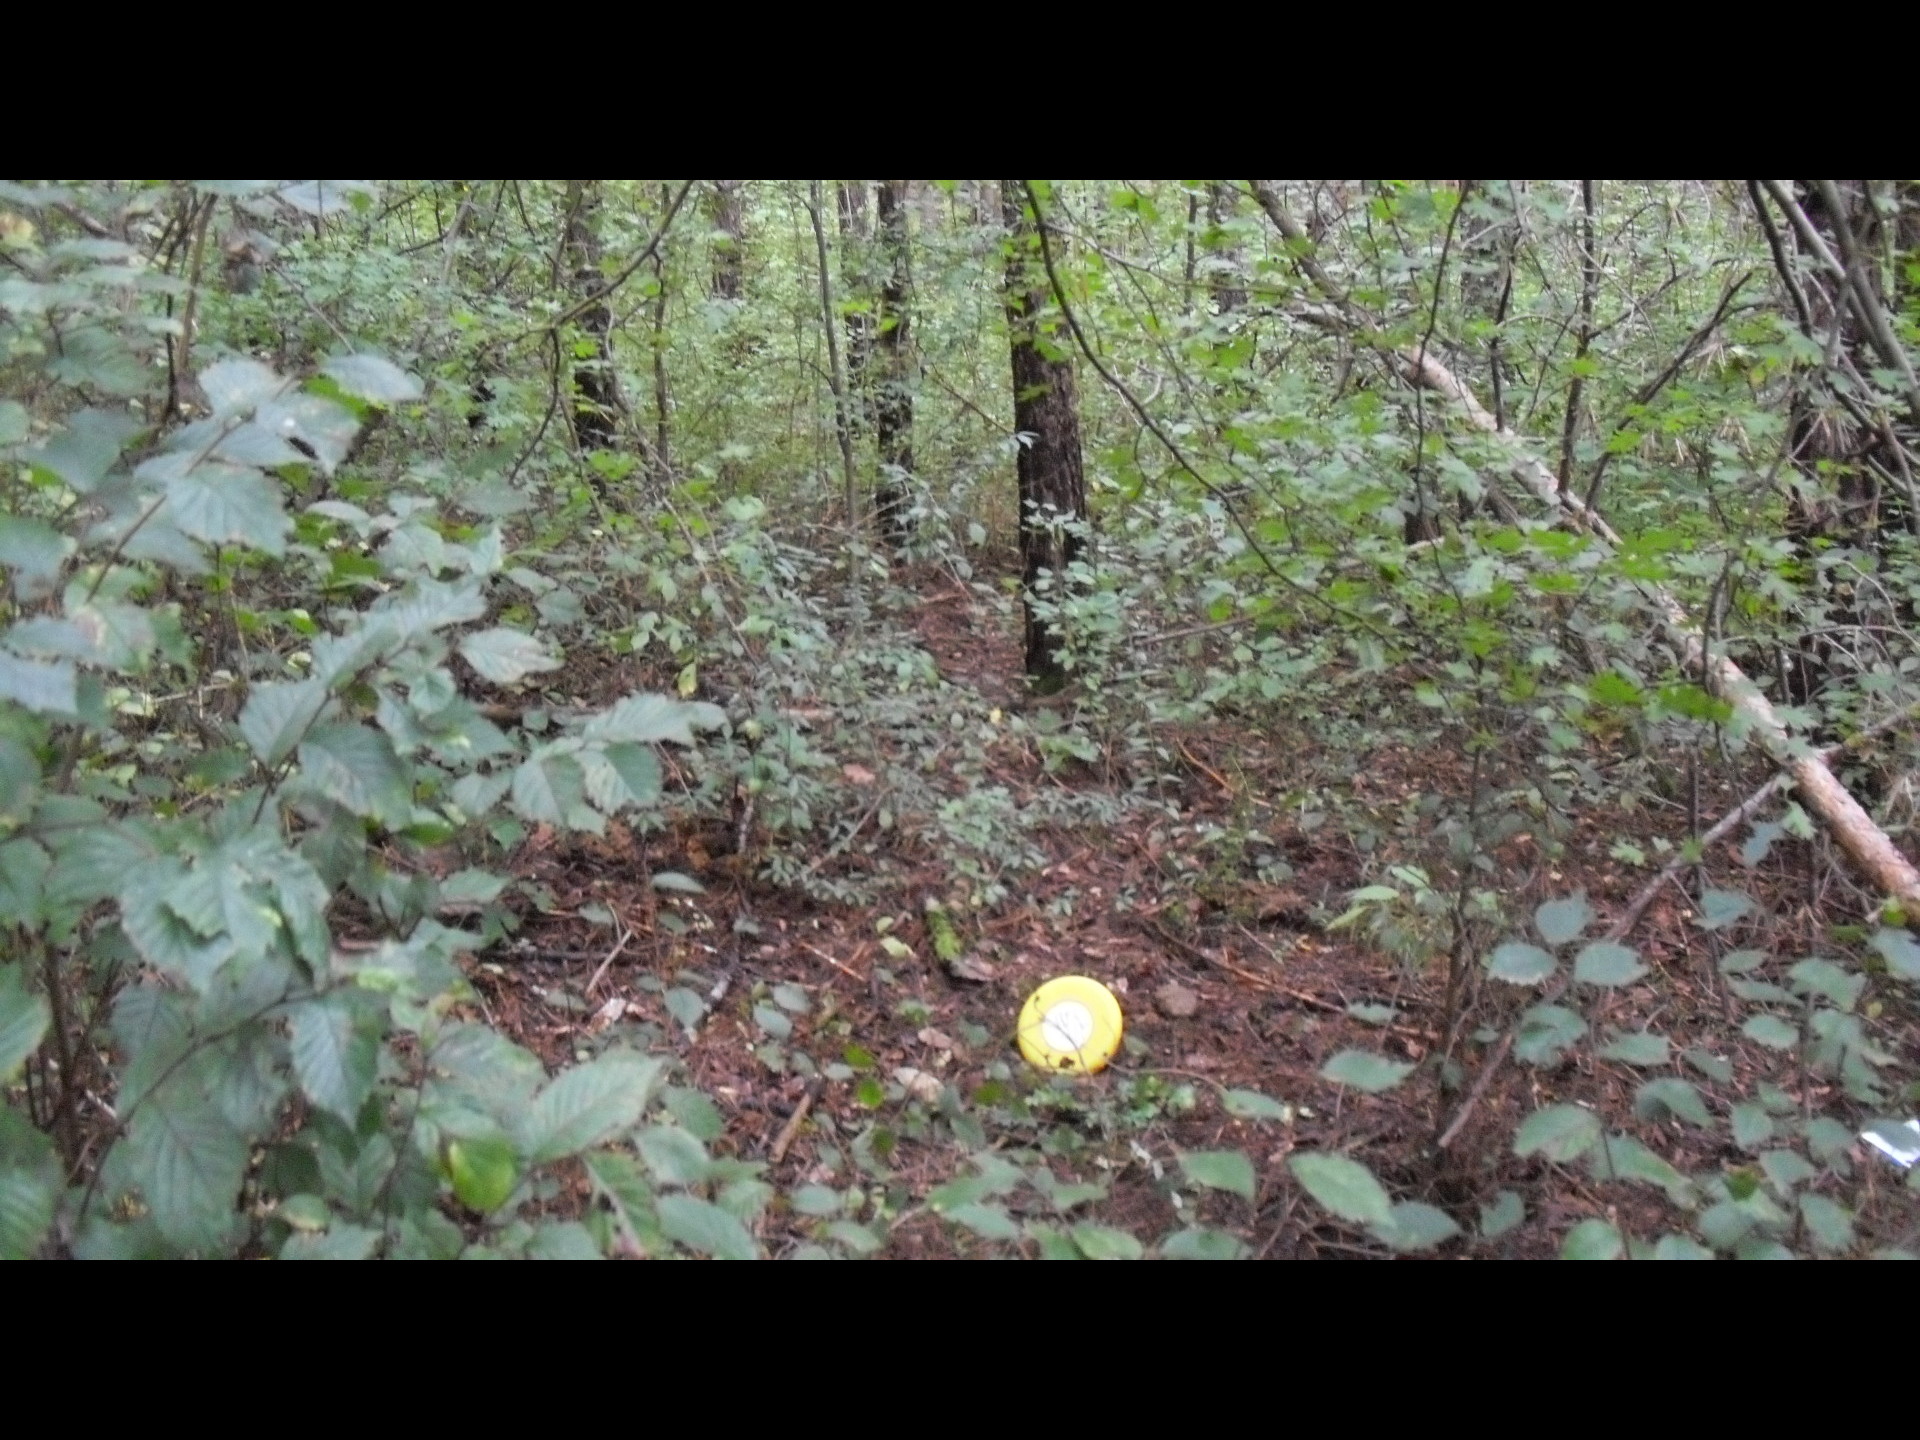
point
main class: Woodland
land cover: Pine dominated mixed woodland
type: hemiboreal forest and nemoral coniferous forest and mixed broadleaved-coniferous forest
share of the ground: > 75 %
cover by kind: coniferous forest trees 75 %, broadleaved forest trees 25 %
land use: Forestry
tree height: > 5 m
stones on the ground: 10 - 25 %
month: September
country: BG
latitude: 43.3337
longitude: 23.0984
